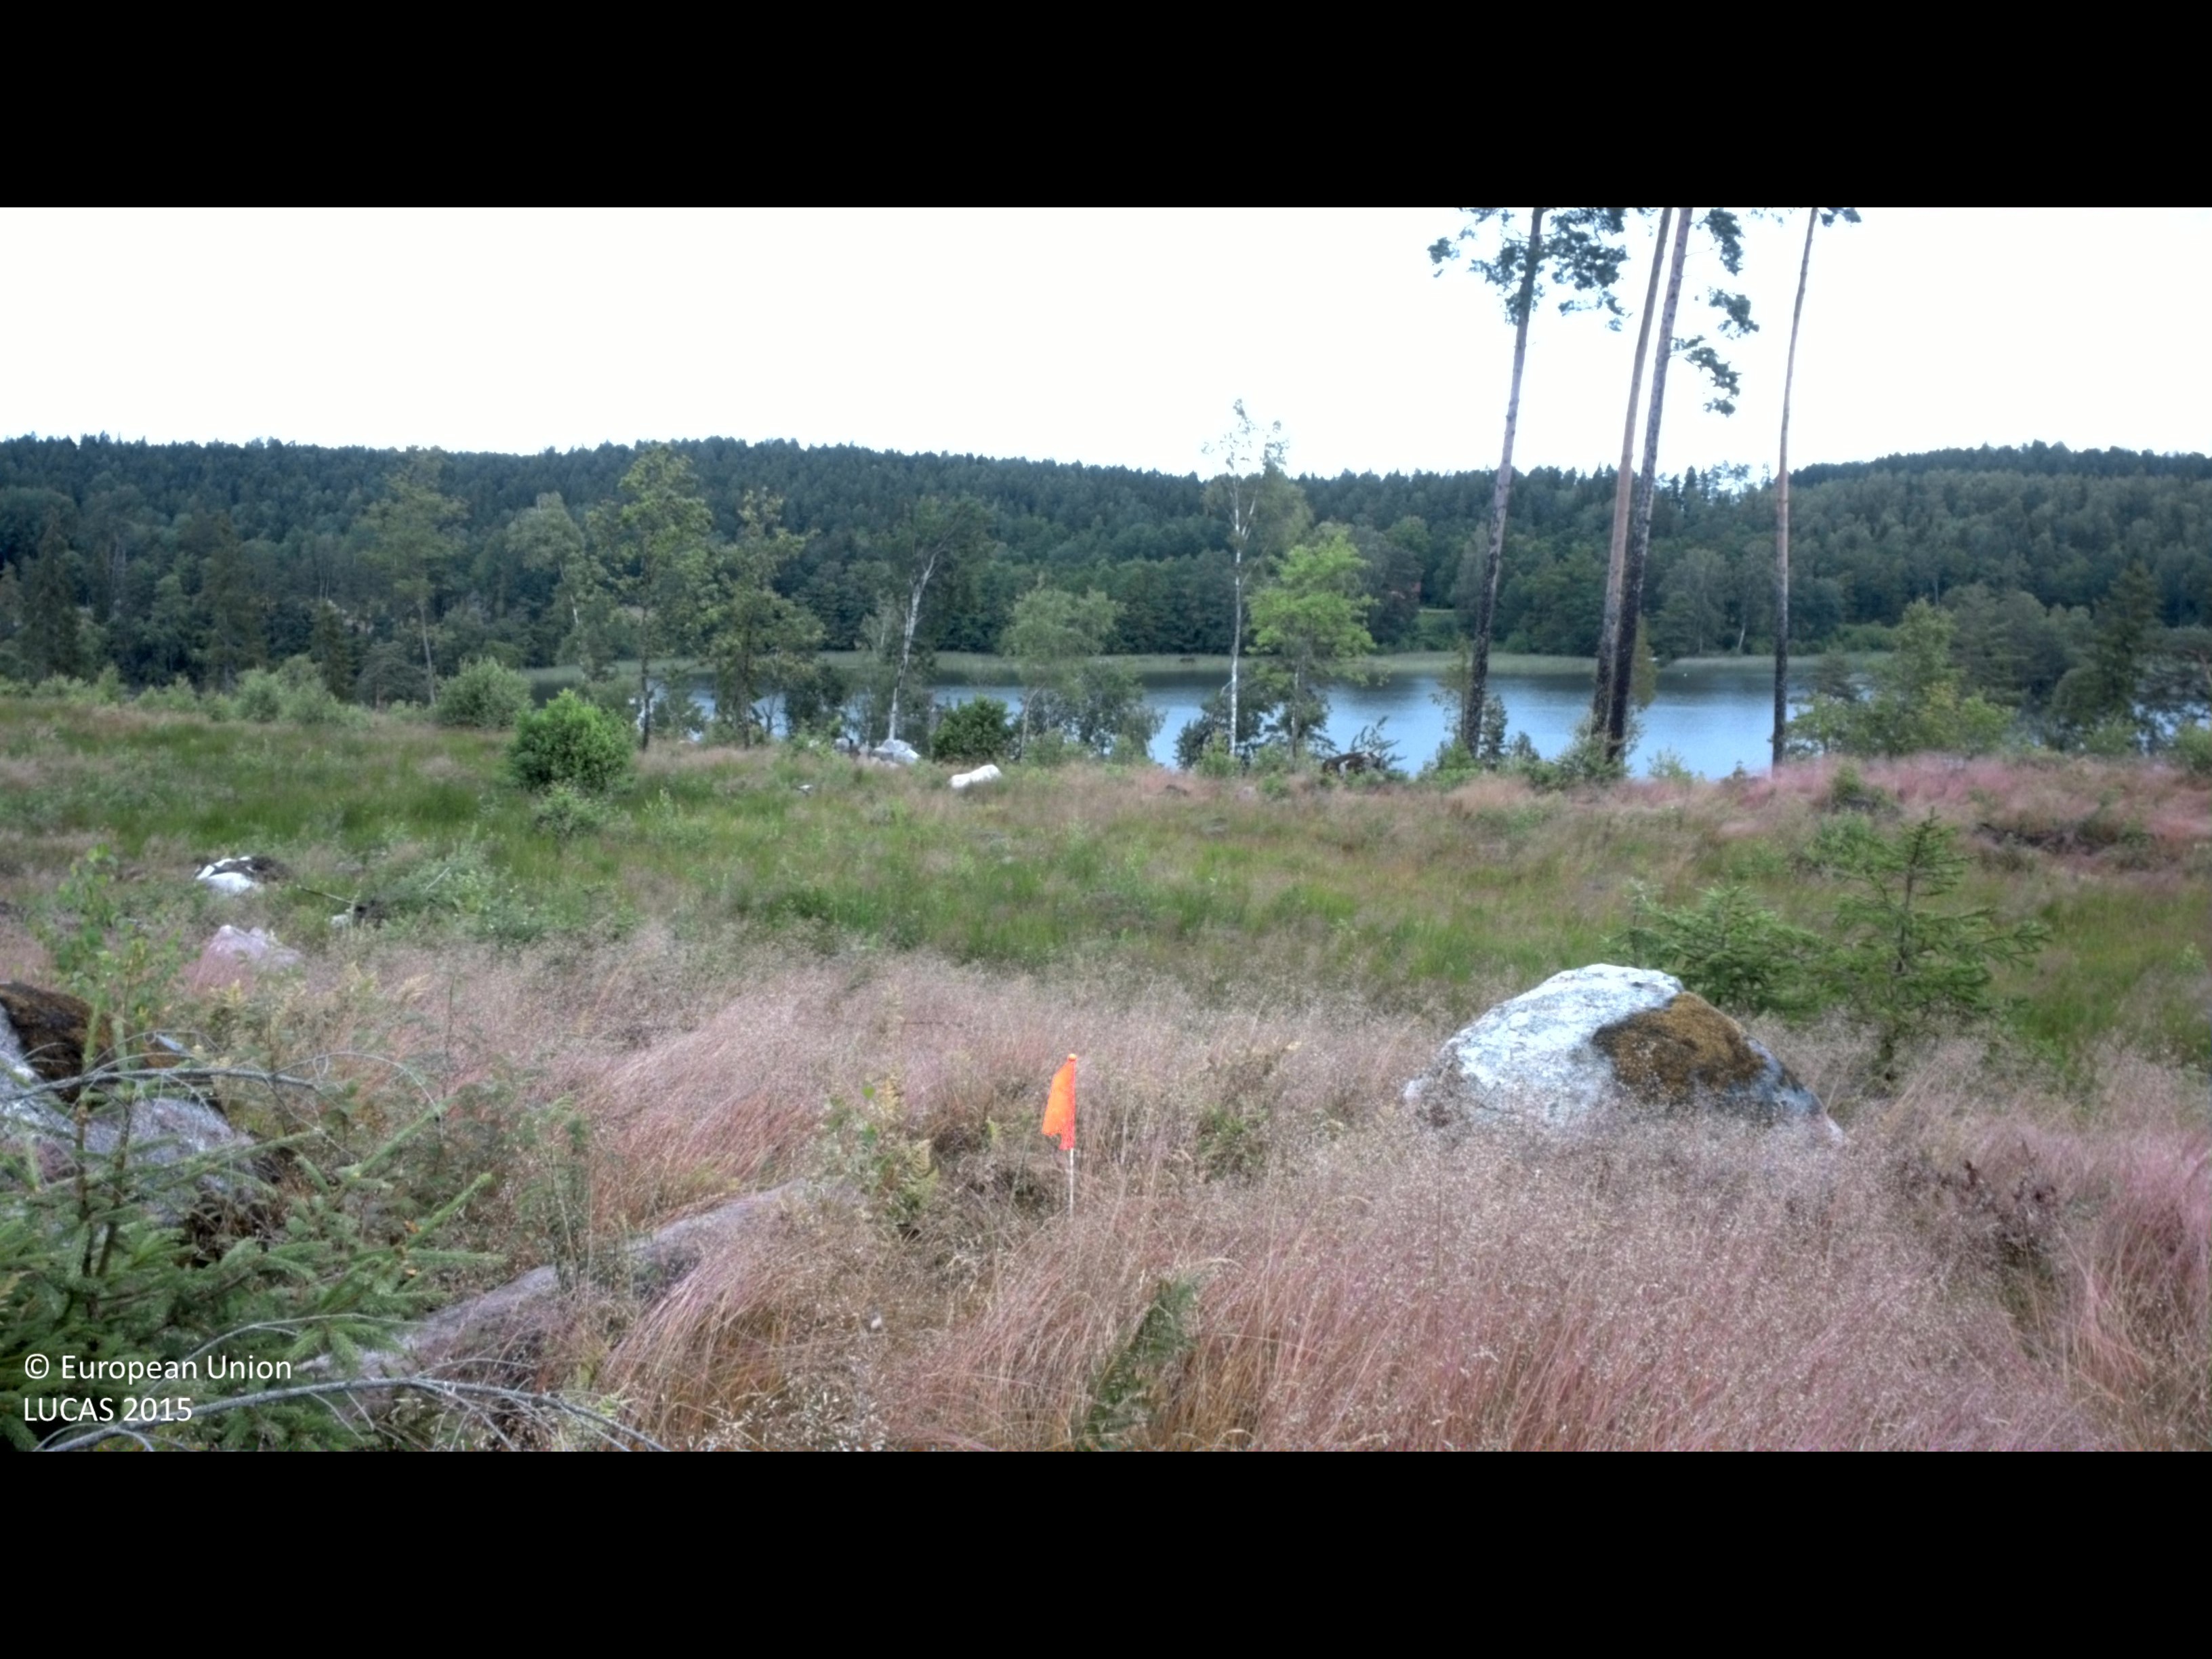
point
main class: Woodland
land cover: Other mixed woodland
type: boreal forest
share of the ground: 10 - 25 %
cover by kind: shrubs 45 %, herbaceous plants 40 %, broadleaved forest trees 10 %, coniferous forest trees 5 %
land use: Forestry
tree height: < 5 m
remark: Clear cut
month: July
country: SE
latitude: 58.3146
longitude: 16.1237
